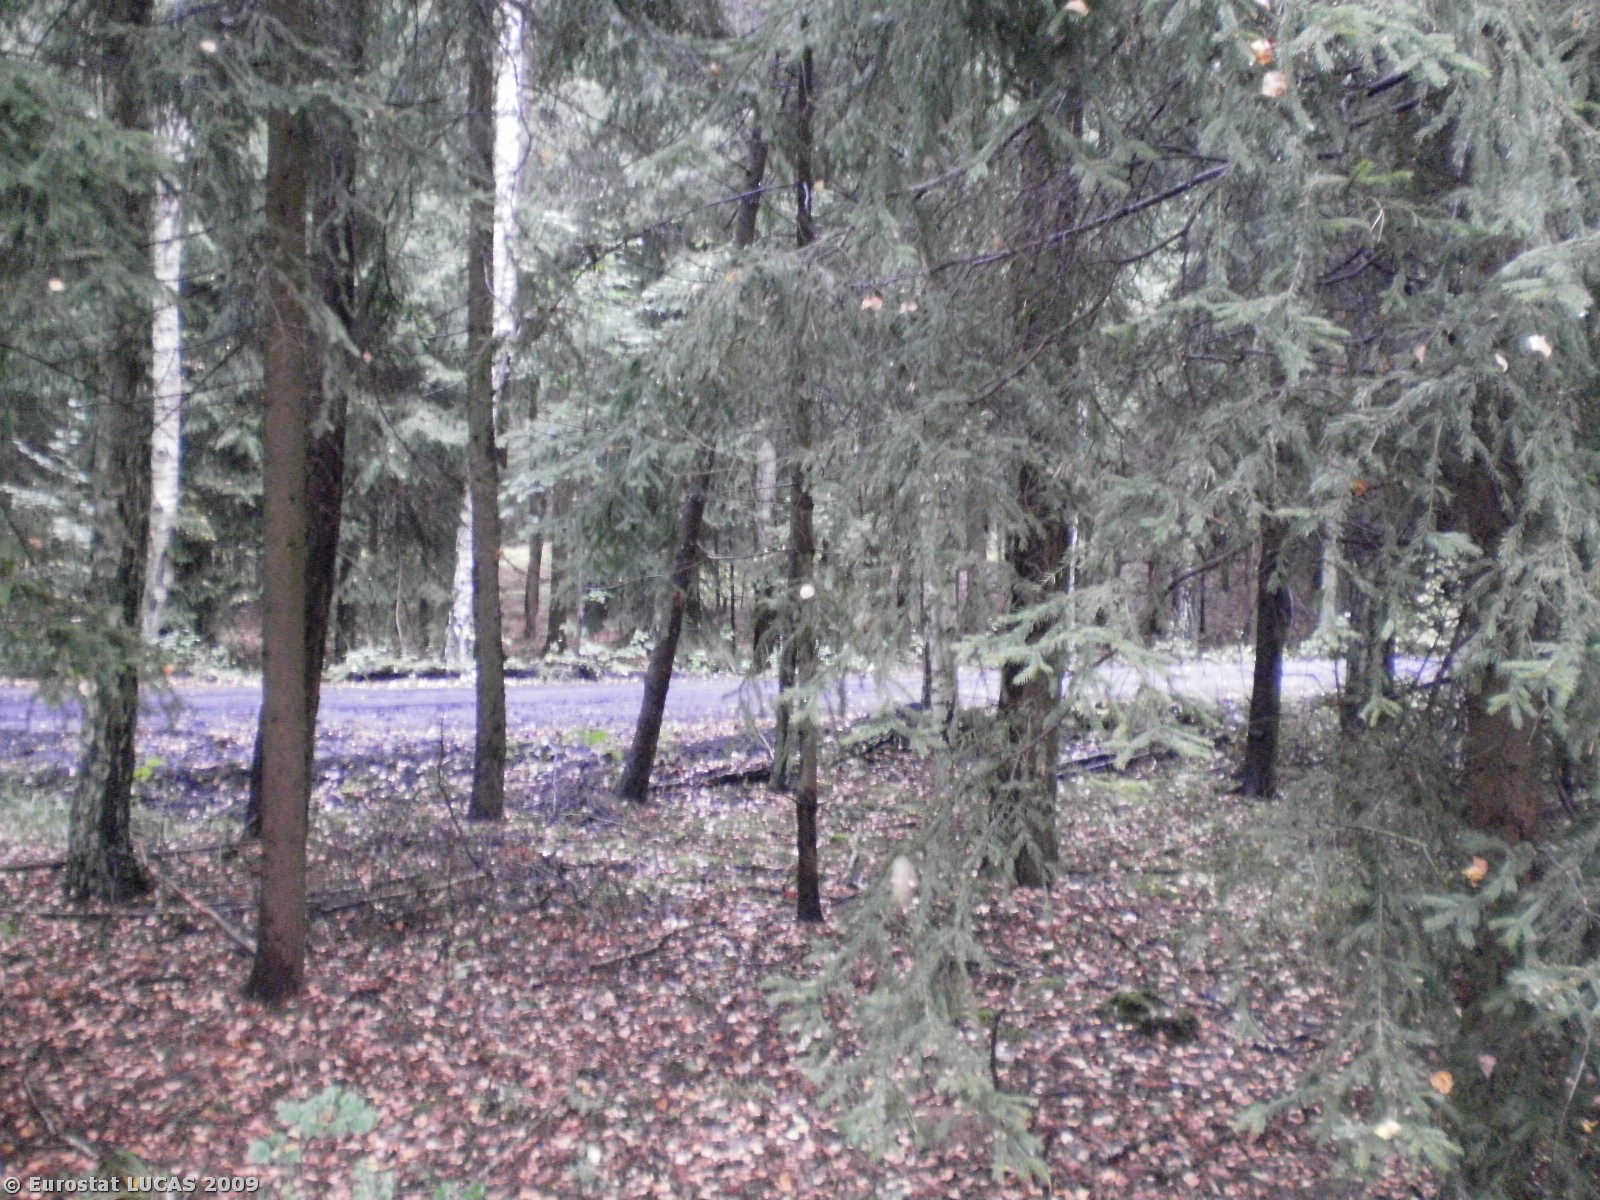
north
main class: Woodland
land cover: Mixed woodland
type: hemiboreal forest and nemoral coniferous forest and mixed broadleaved-coniferous forest
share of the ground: > 75 %
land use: Forestry
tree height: > 5 m
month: September
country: PL
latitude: 53.7506
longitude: 17.7318
